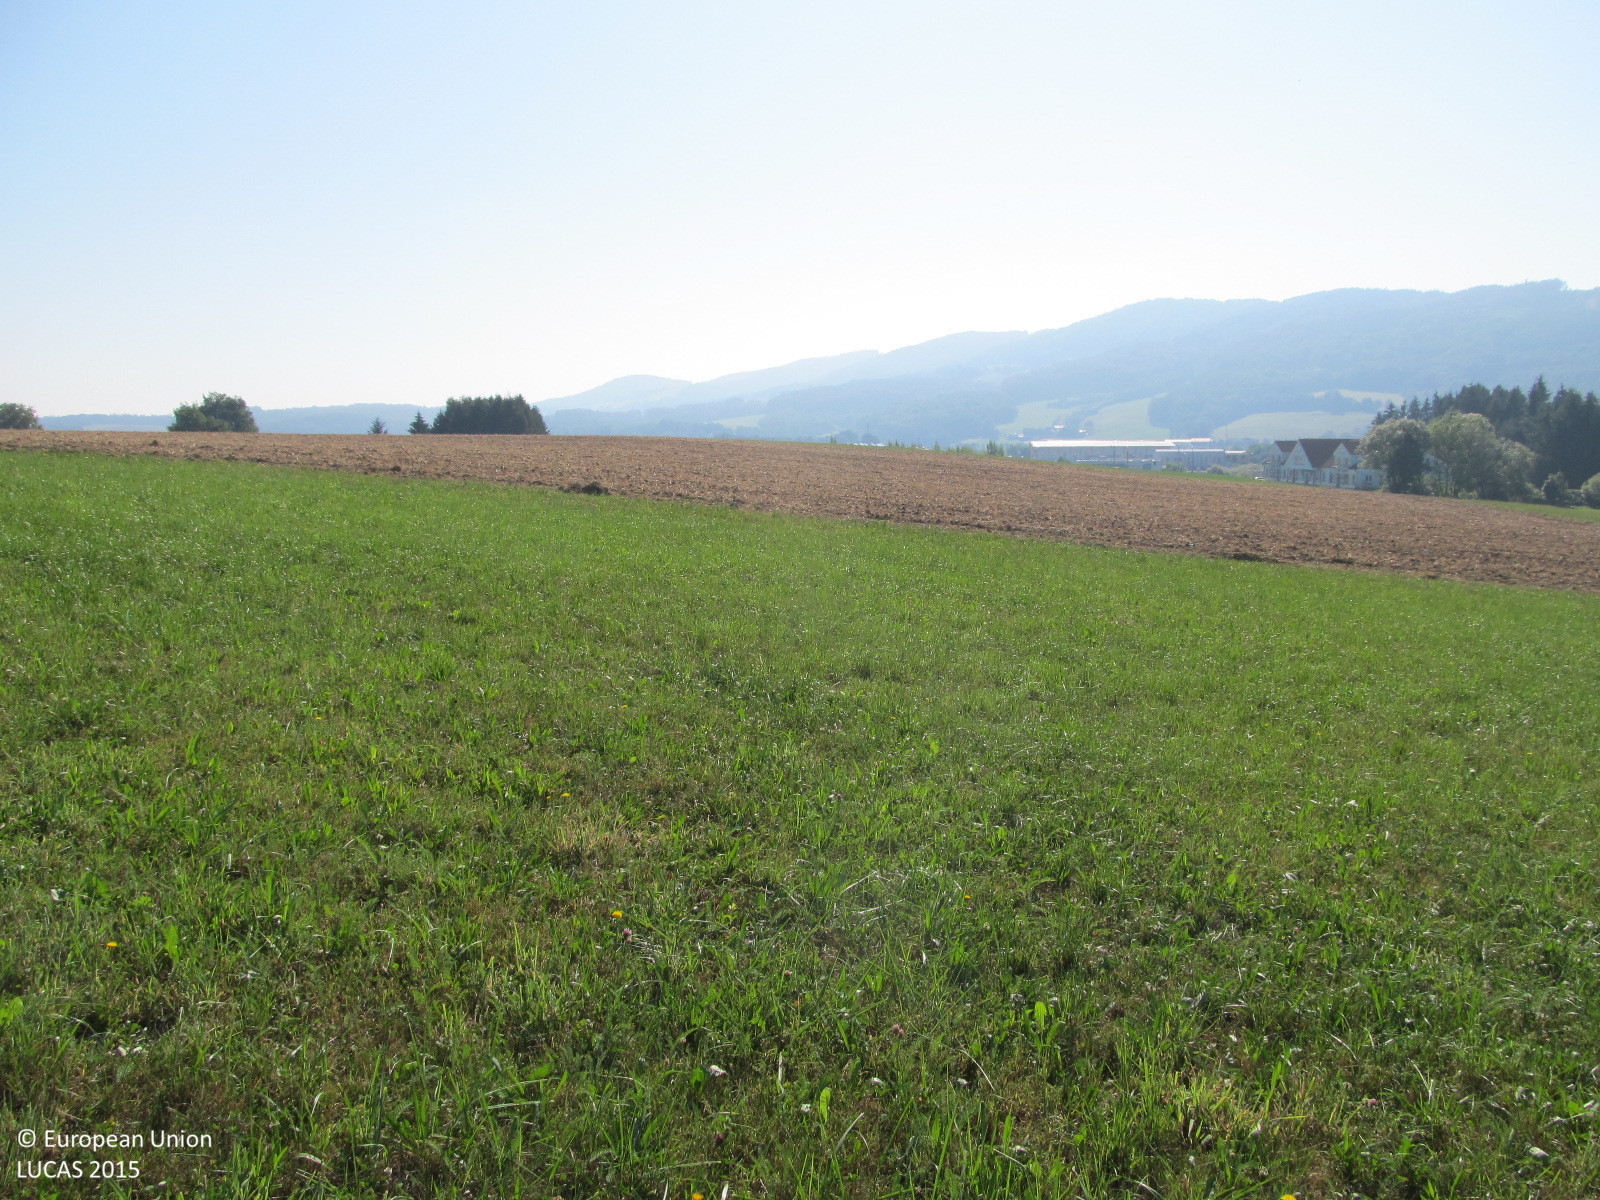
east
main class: Grassland
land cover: Grassland without tree/shrub cover
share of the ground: > 75 %
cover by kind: herbaceous plants 100 %
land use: Agriculture (excluding fallow land and kitchen gardens)
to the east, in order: Grassland without tree/shrub cover; Common wheat; Lucerne
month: August
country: AT
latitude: 48.1171
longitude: 15.6040
